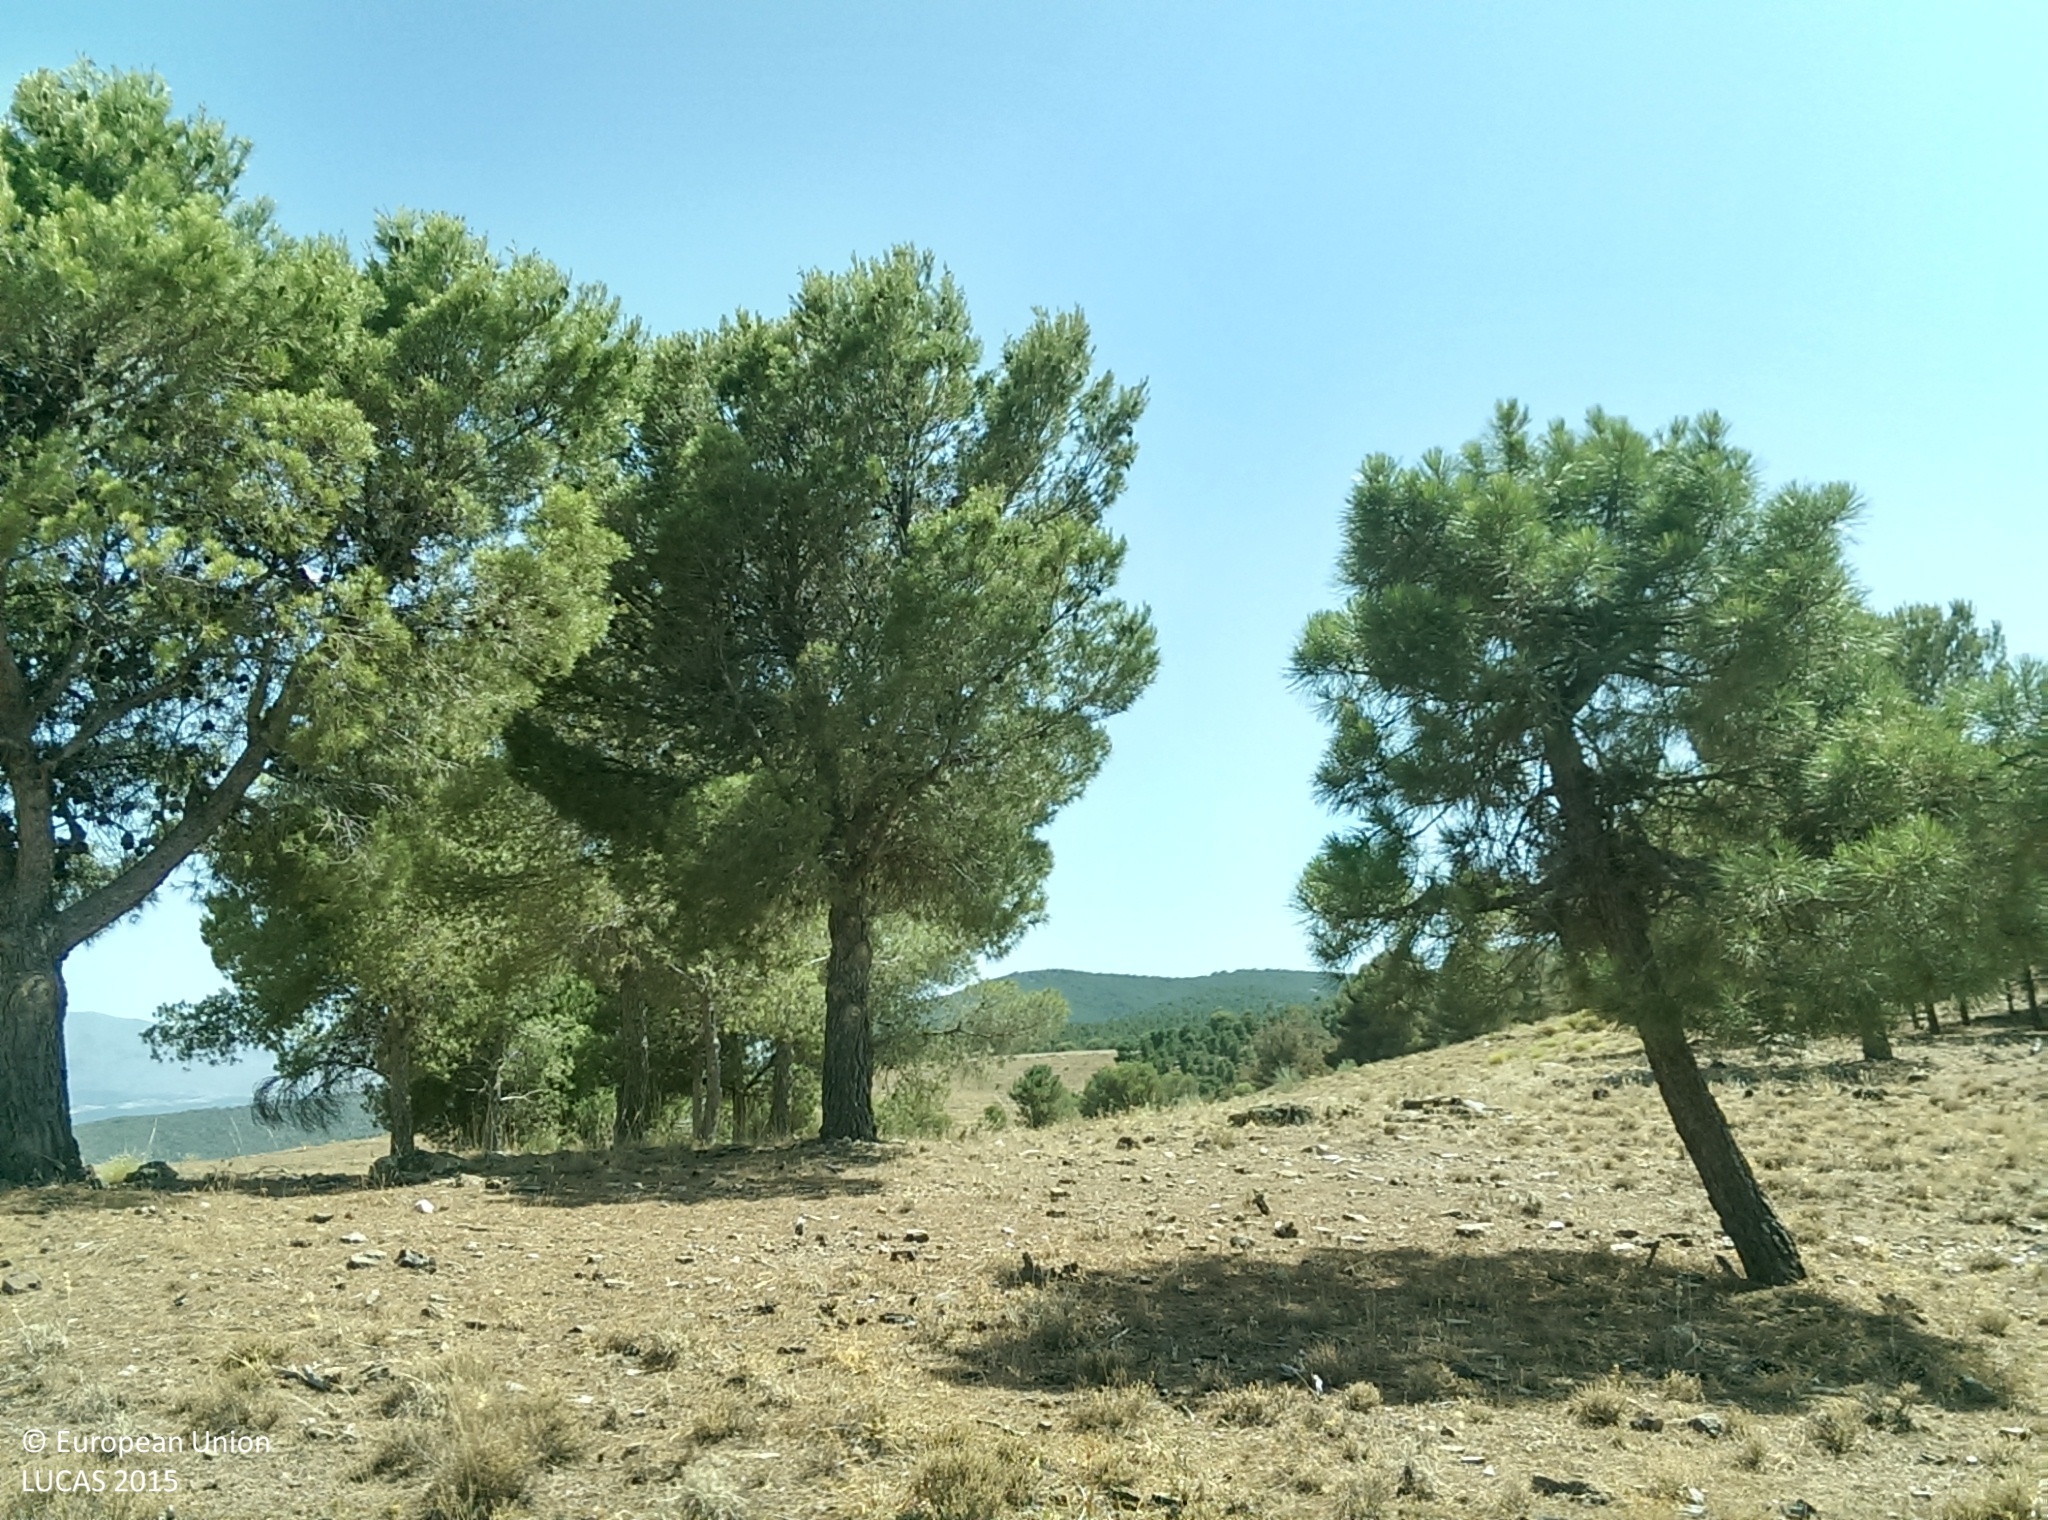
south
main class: Woodland
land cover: Pine dominated coniferous woodland
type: coniferous forest of the mediterranean region
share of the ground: 10 - 25 %
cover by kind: herbaceous plants 40 %, coniferous forest trees 20 %, shrubs 20 %, unconsolidated bare surface 20 %
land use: Forestry
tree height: > 5 m
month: July
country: ES
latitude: 37.2289
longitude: -3.1846
